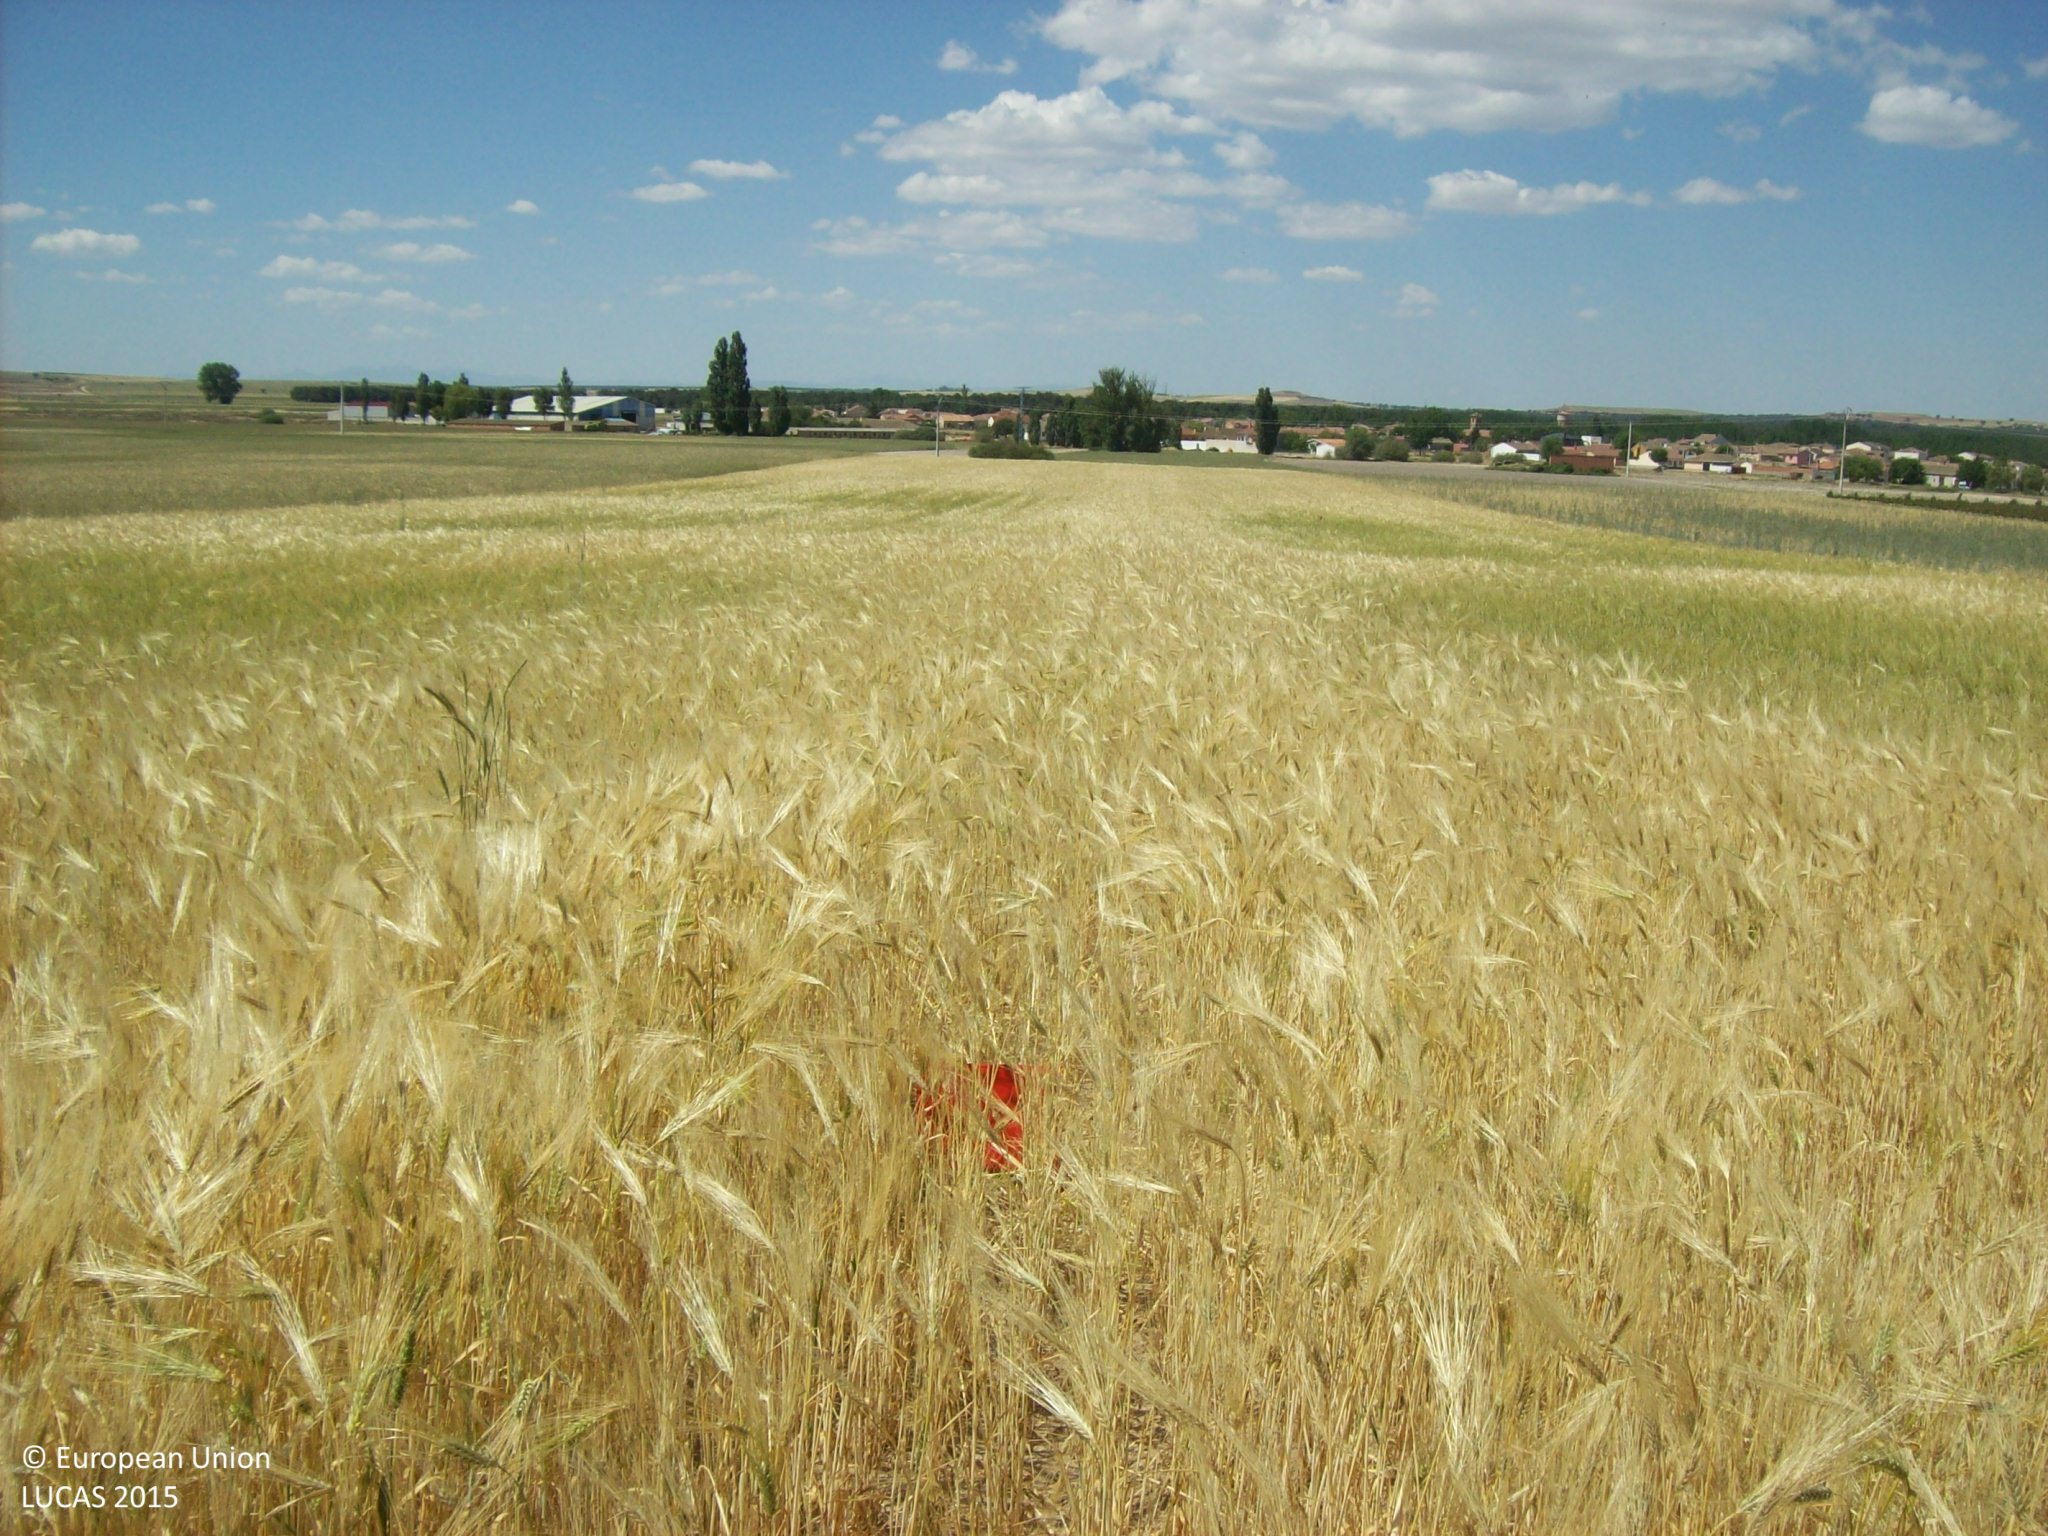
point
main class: Cropland
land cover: Barley
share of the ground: > 75 %
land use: Agriculture (excluding fallow land and kitchen gardens)
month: June
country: ES
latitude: 41.0348
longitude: -4.5096
